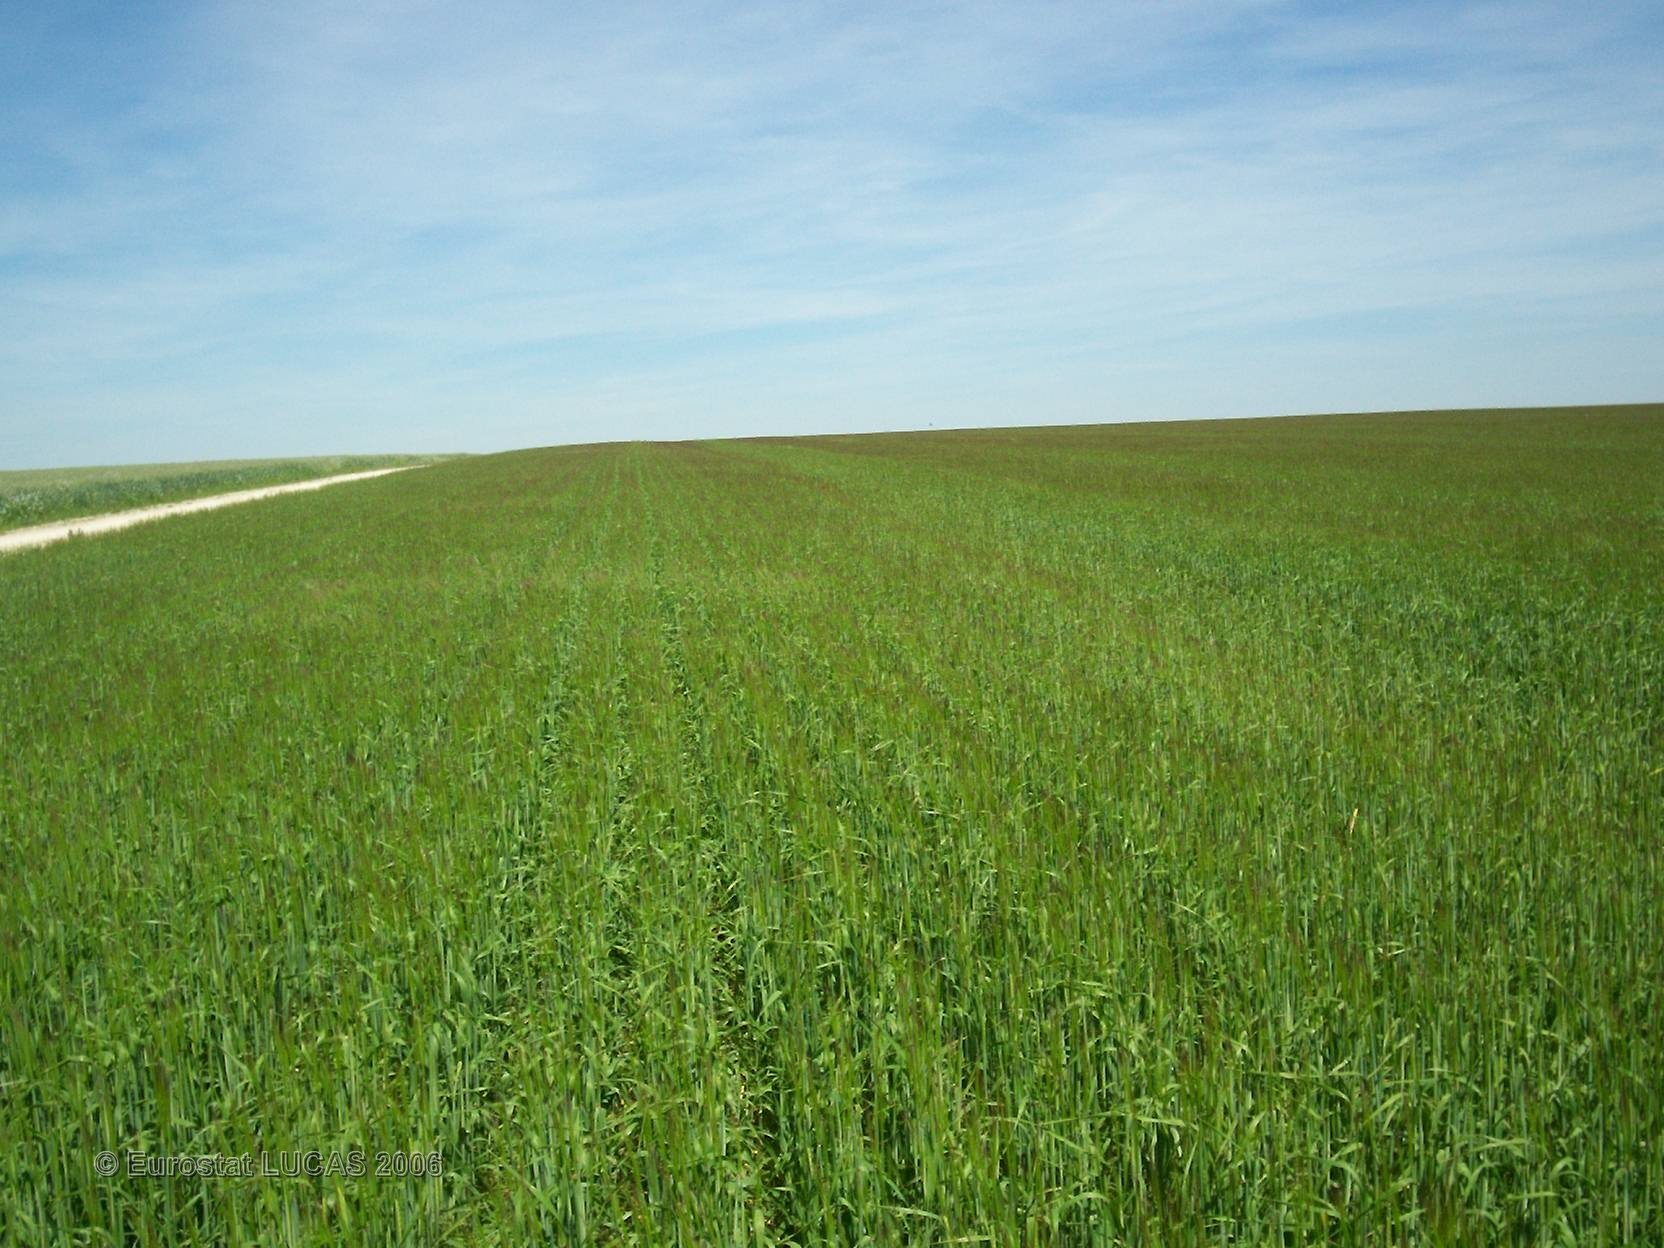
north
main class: Cropland
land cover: Barley
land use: Agriculture (excluding fallow land and kitchen gardens)
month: June
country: FR
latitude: 49.0645
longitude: 4.5906
